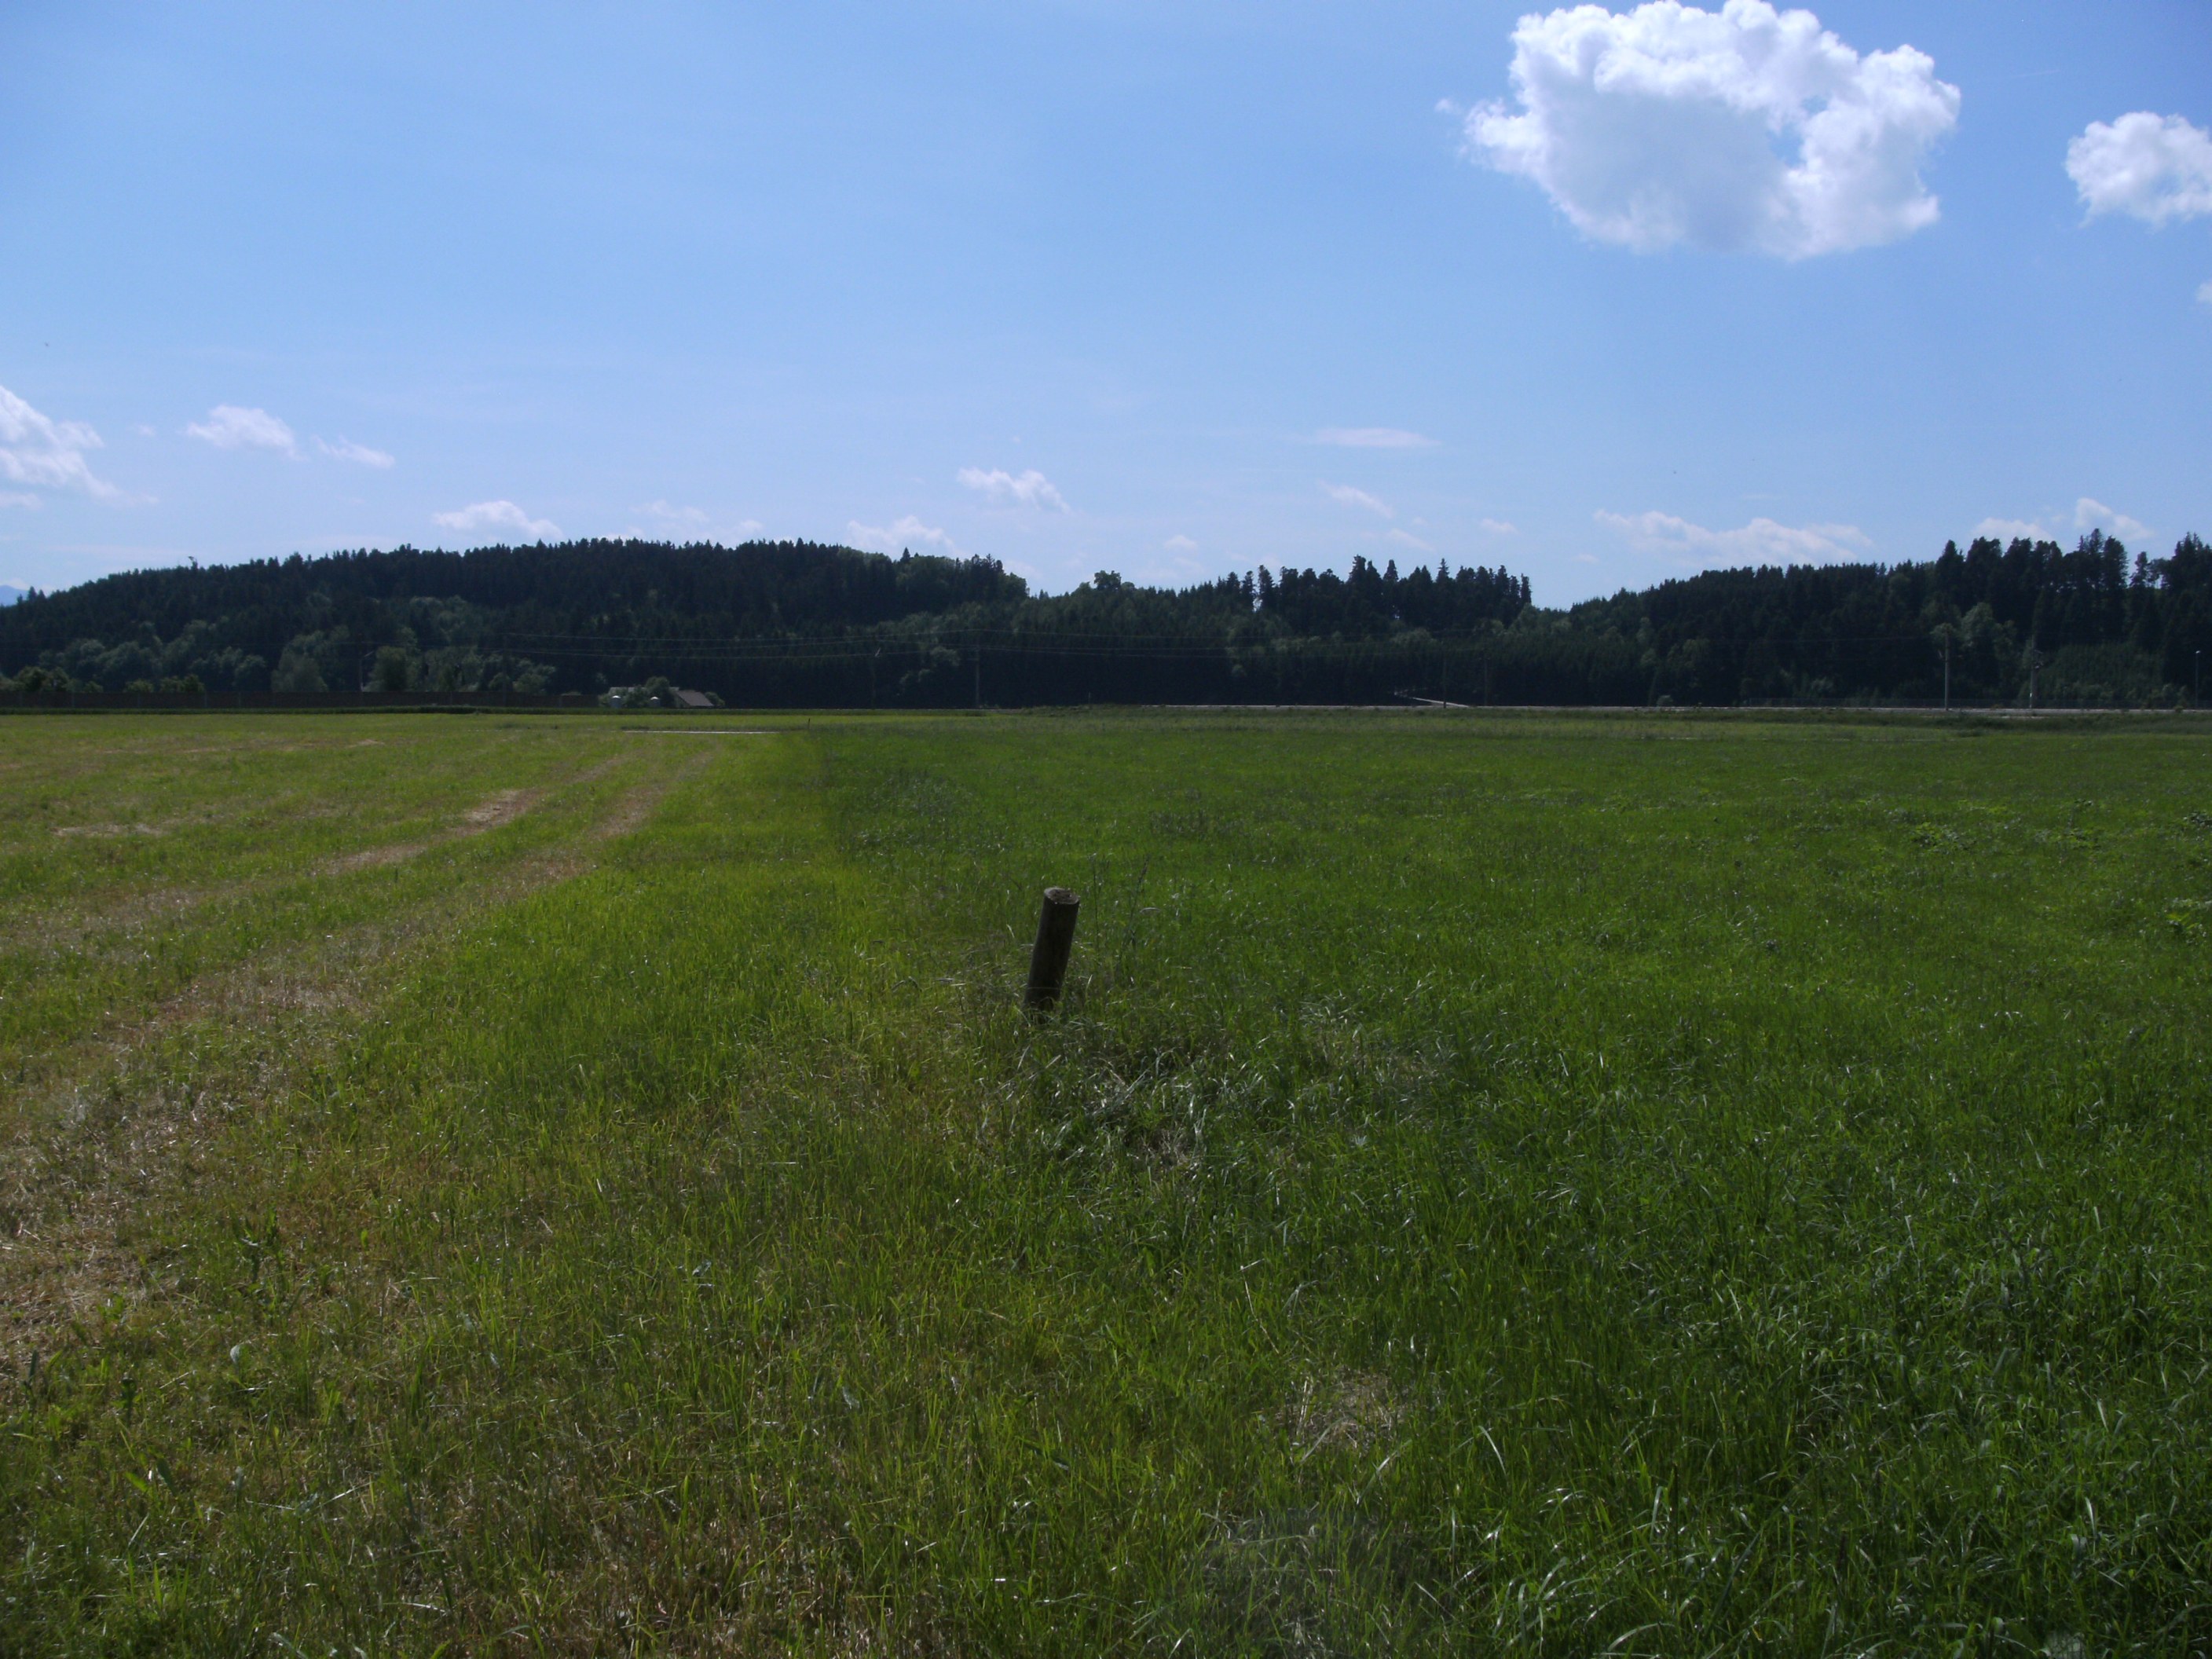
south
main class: Grassland
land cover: Grassland without tree/shrub cover
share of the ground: > 75 %
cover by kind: herbaceous plants 100 %
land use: Agriculture (excluding fallow land and kitchen gardens)
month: May
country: AT
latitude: 48.0222
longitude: 13.5523
